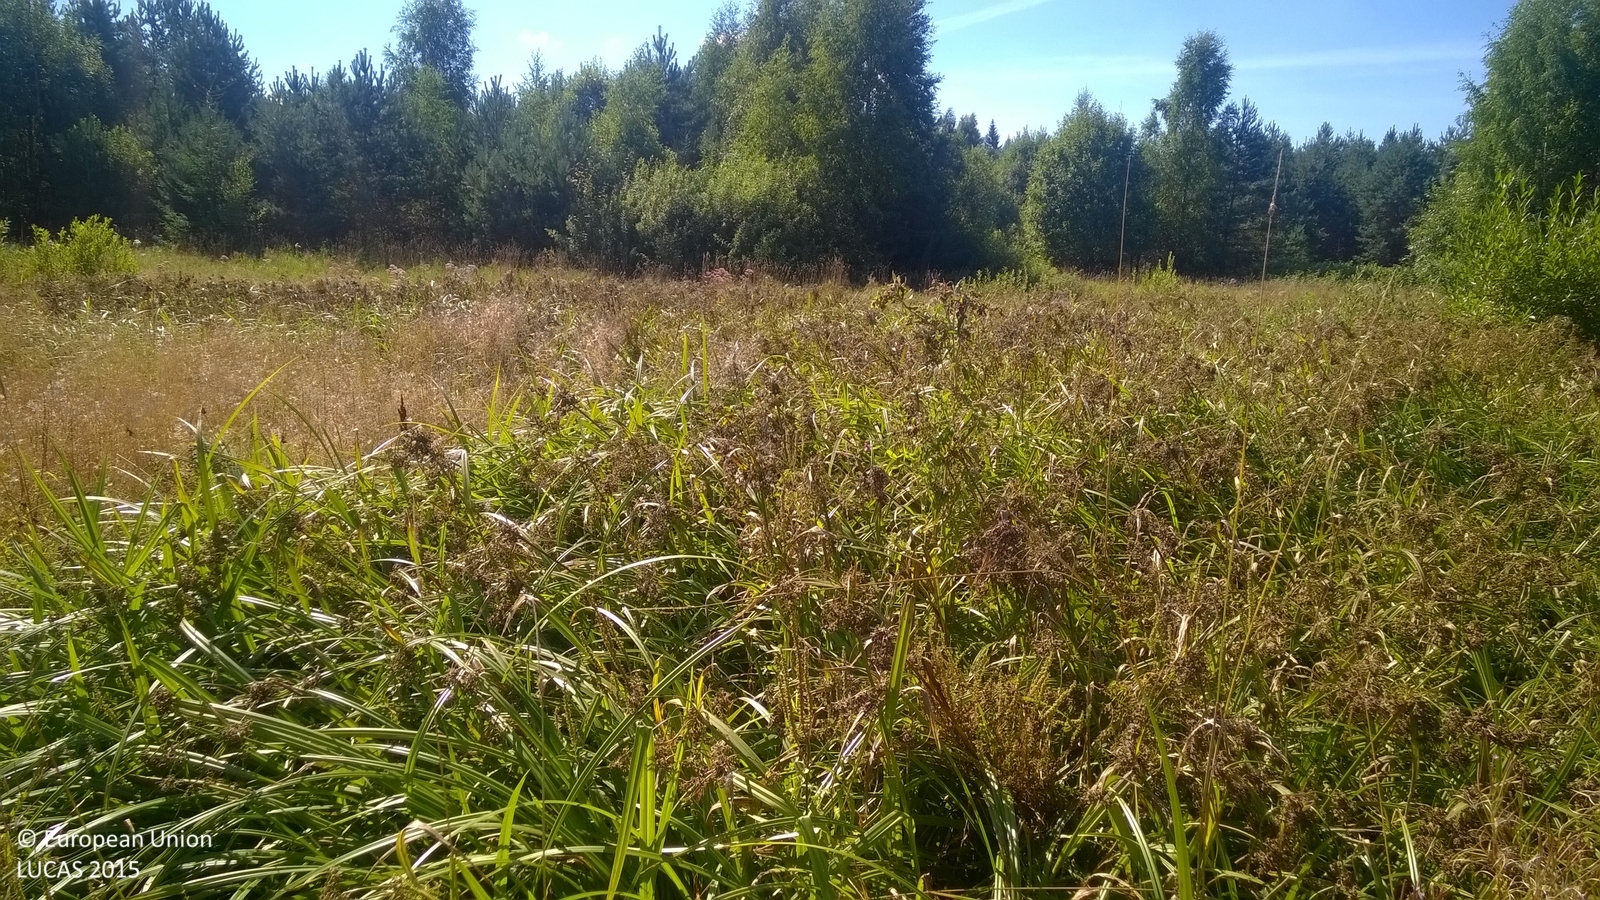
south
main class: Grassland
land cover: Spontaneously vegetated surfaces
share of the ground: > 75 %
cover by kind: herbaceous plants 95 %, shrubs 5 %
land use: Semi-natural and natural areas not in use
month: August
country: LV
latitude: 57.7141
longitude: 26.1273
